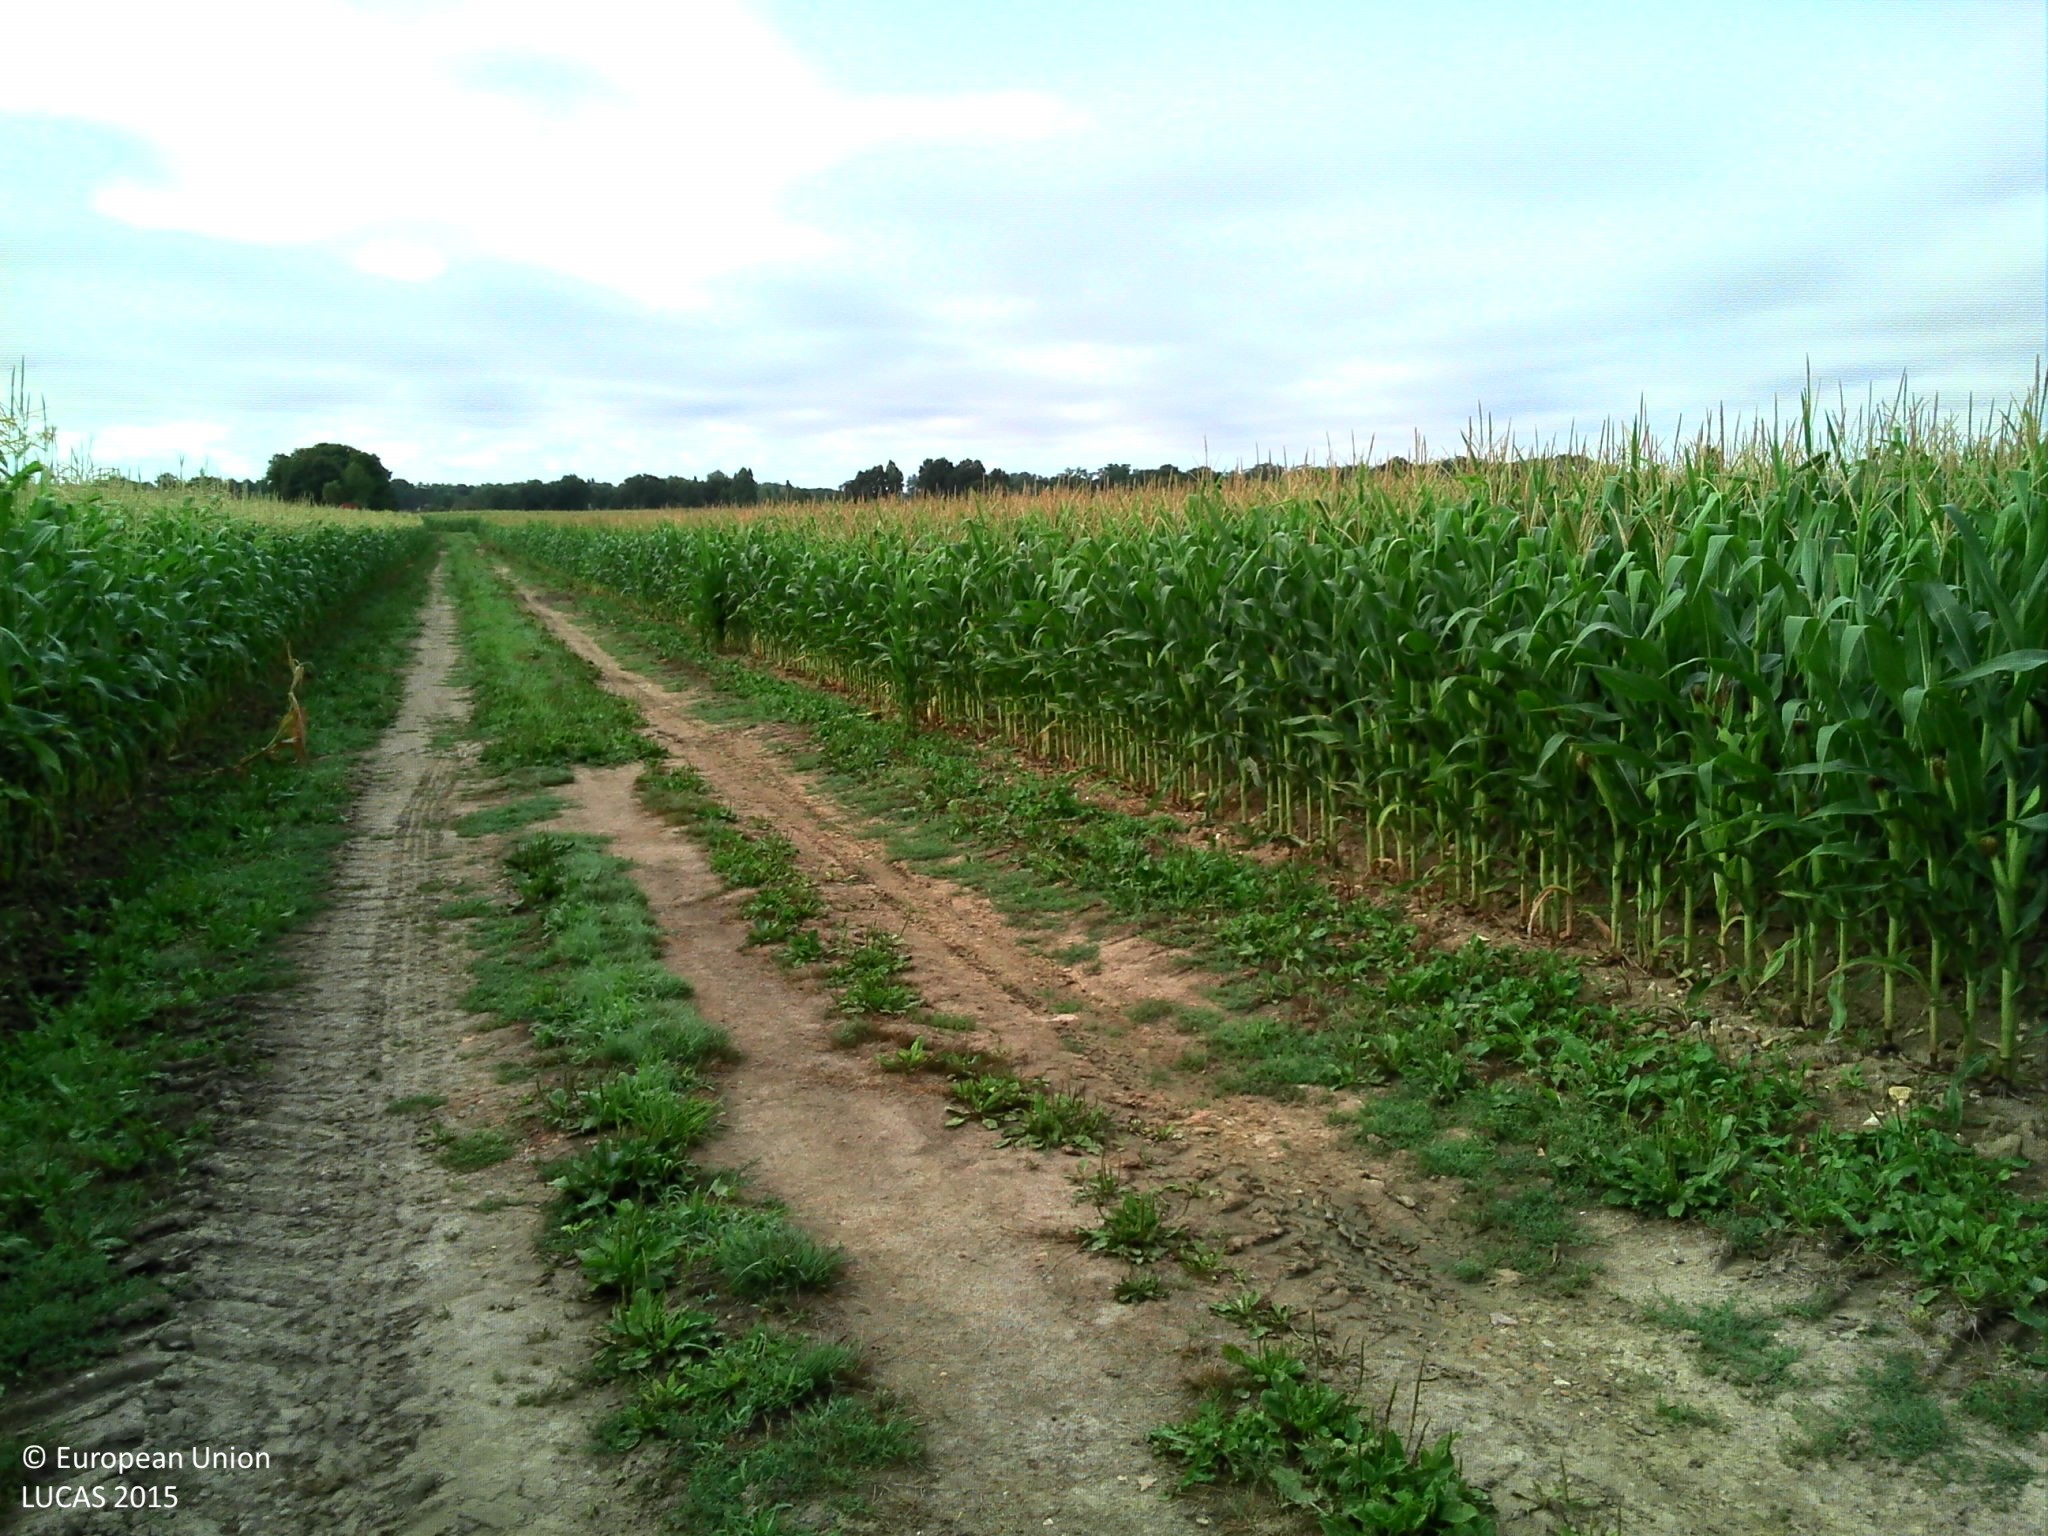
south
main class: Cropland
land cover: Maize
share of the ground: > 75 %
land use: Agriculture (excluding fallow land and kitchen gardens)
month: July
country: FR
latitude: 46.3098
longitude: 0.5174
